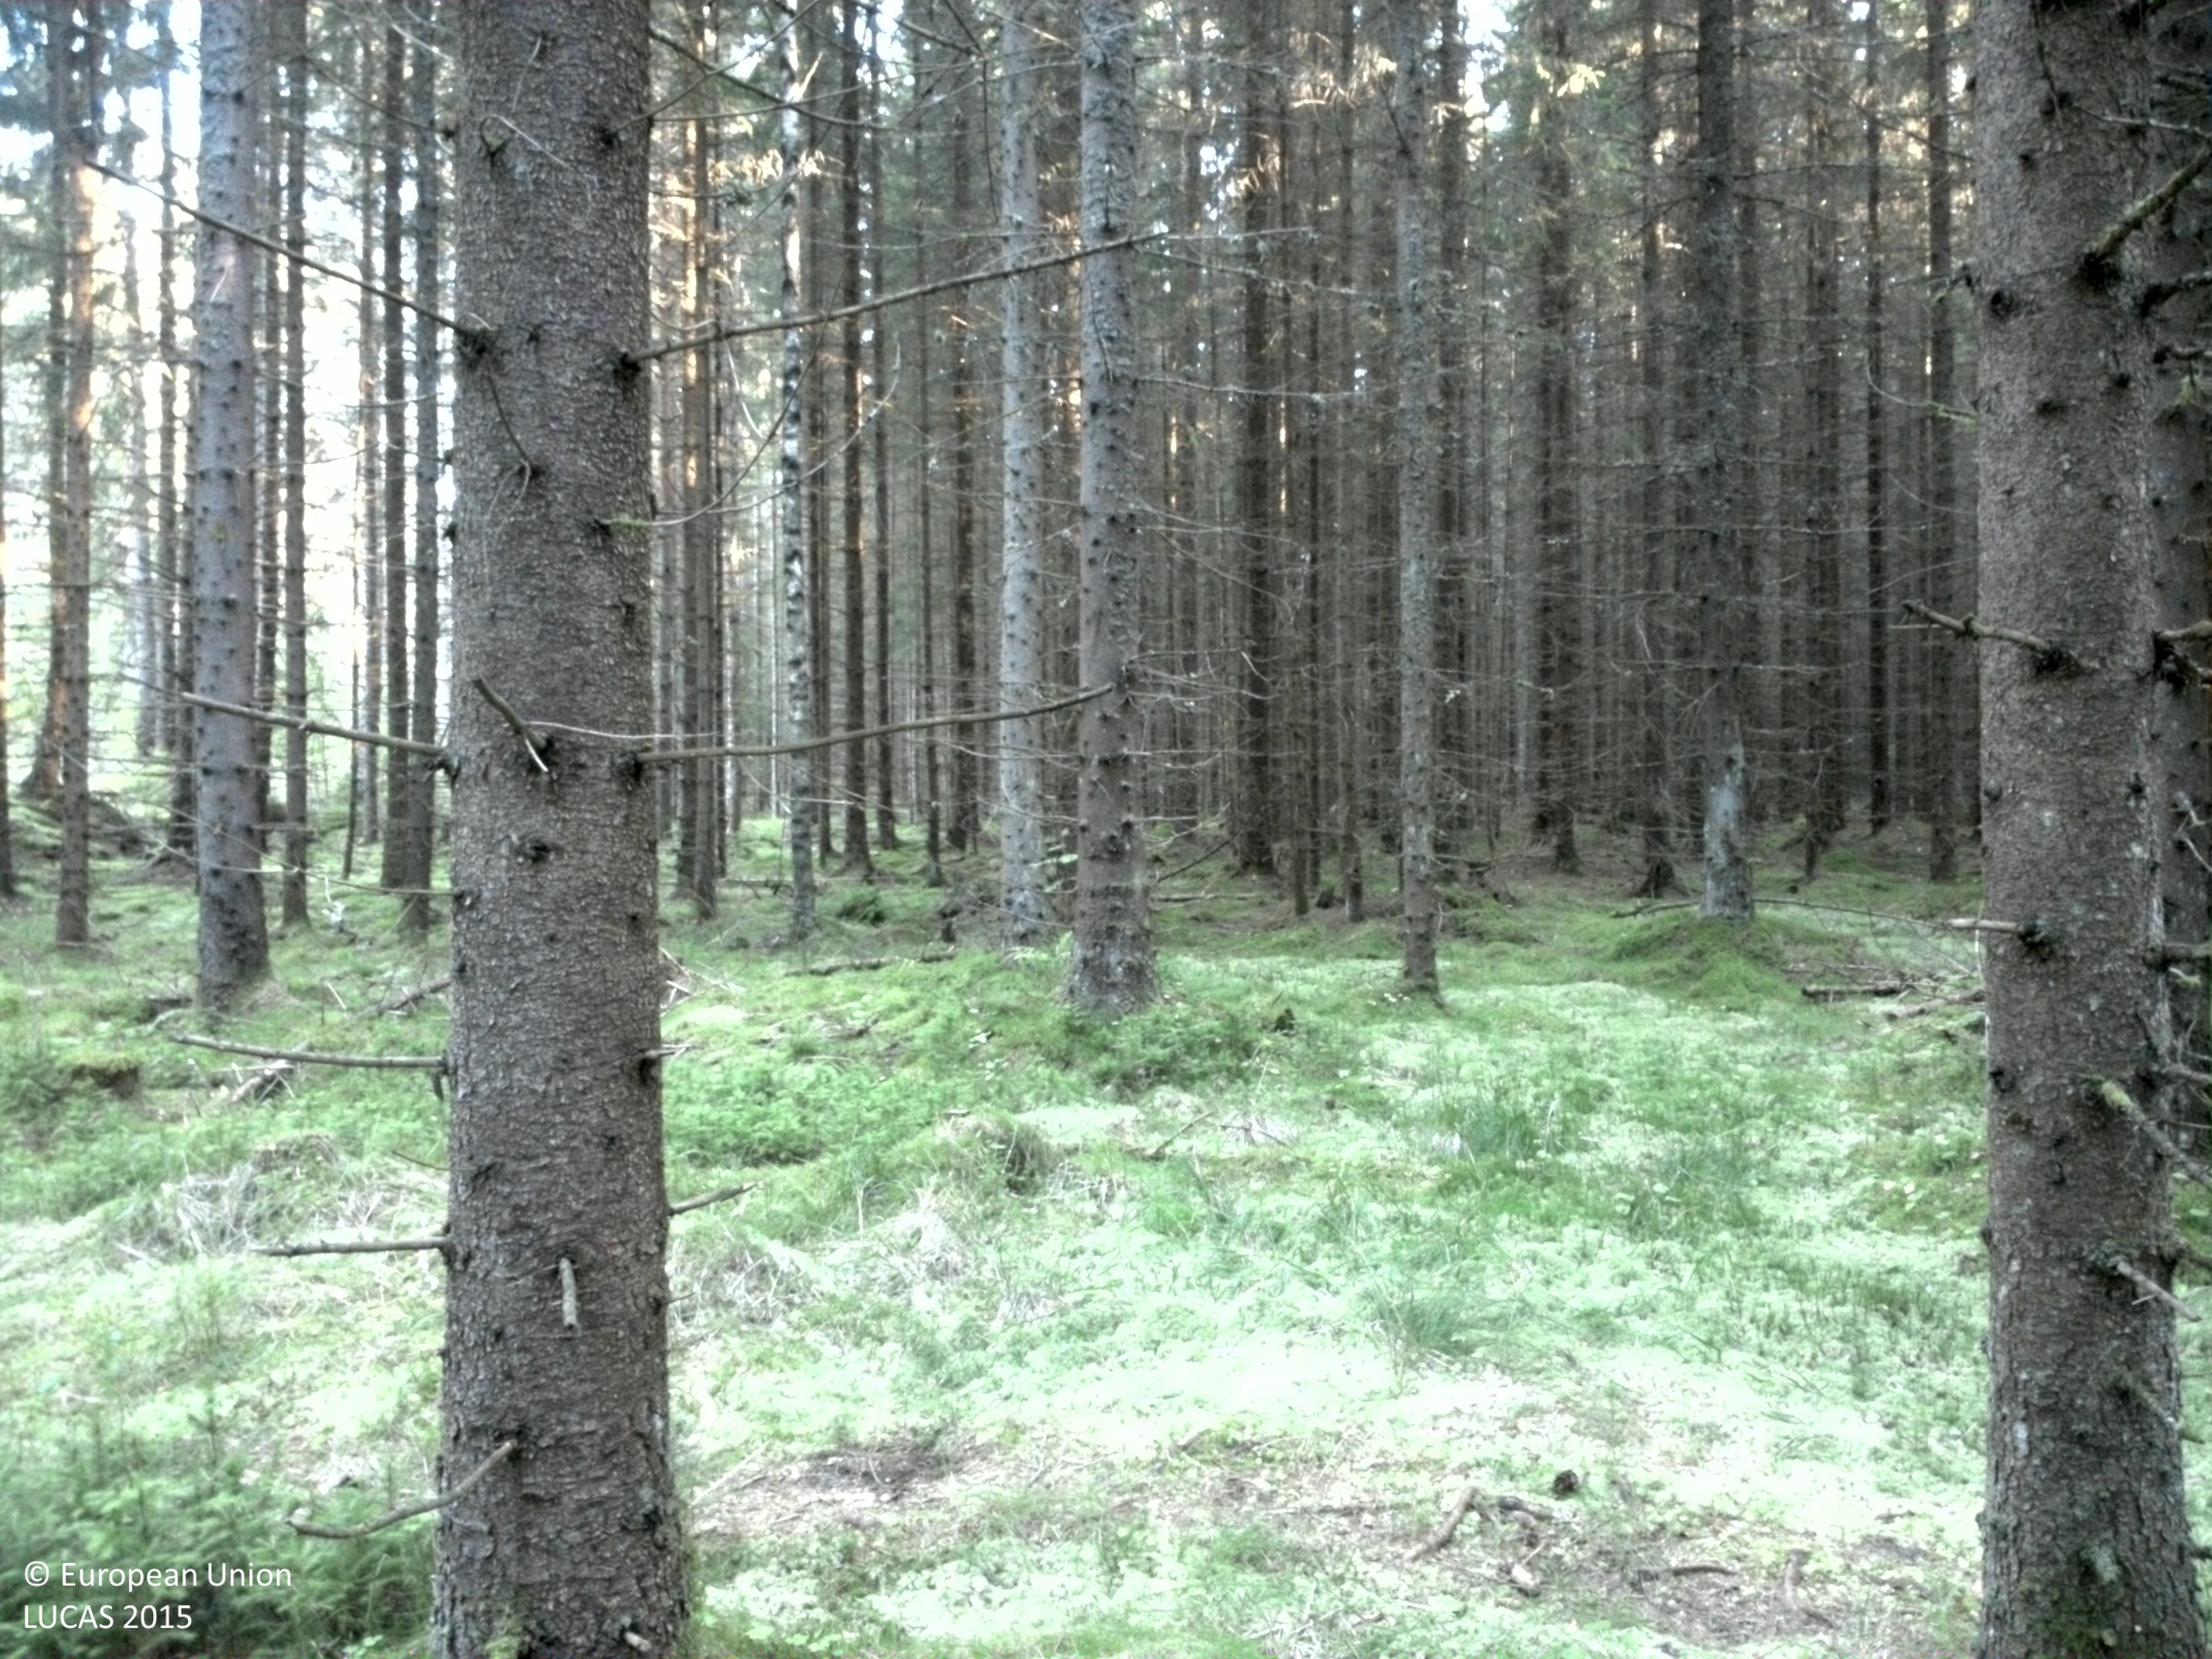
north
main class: Woodland
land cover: Spruce dominated coniferous woodland
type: boreal forest
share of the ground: 50 - 75 %
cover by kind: coniferous forest trees 75 %, lichens and mosses 20 %, shrubs 5 %
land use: Forestry
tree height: > 5 m
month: August
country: SE
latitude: 59.4355
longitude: 13.4653
